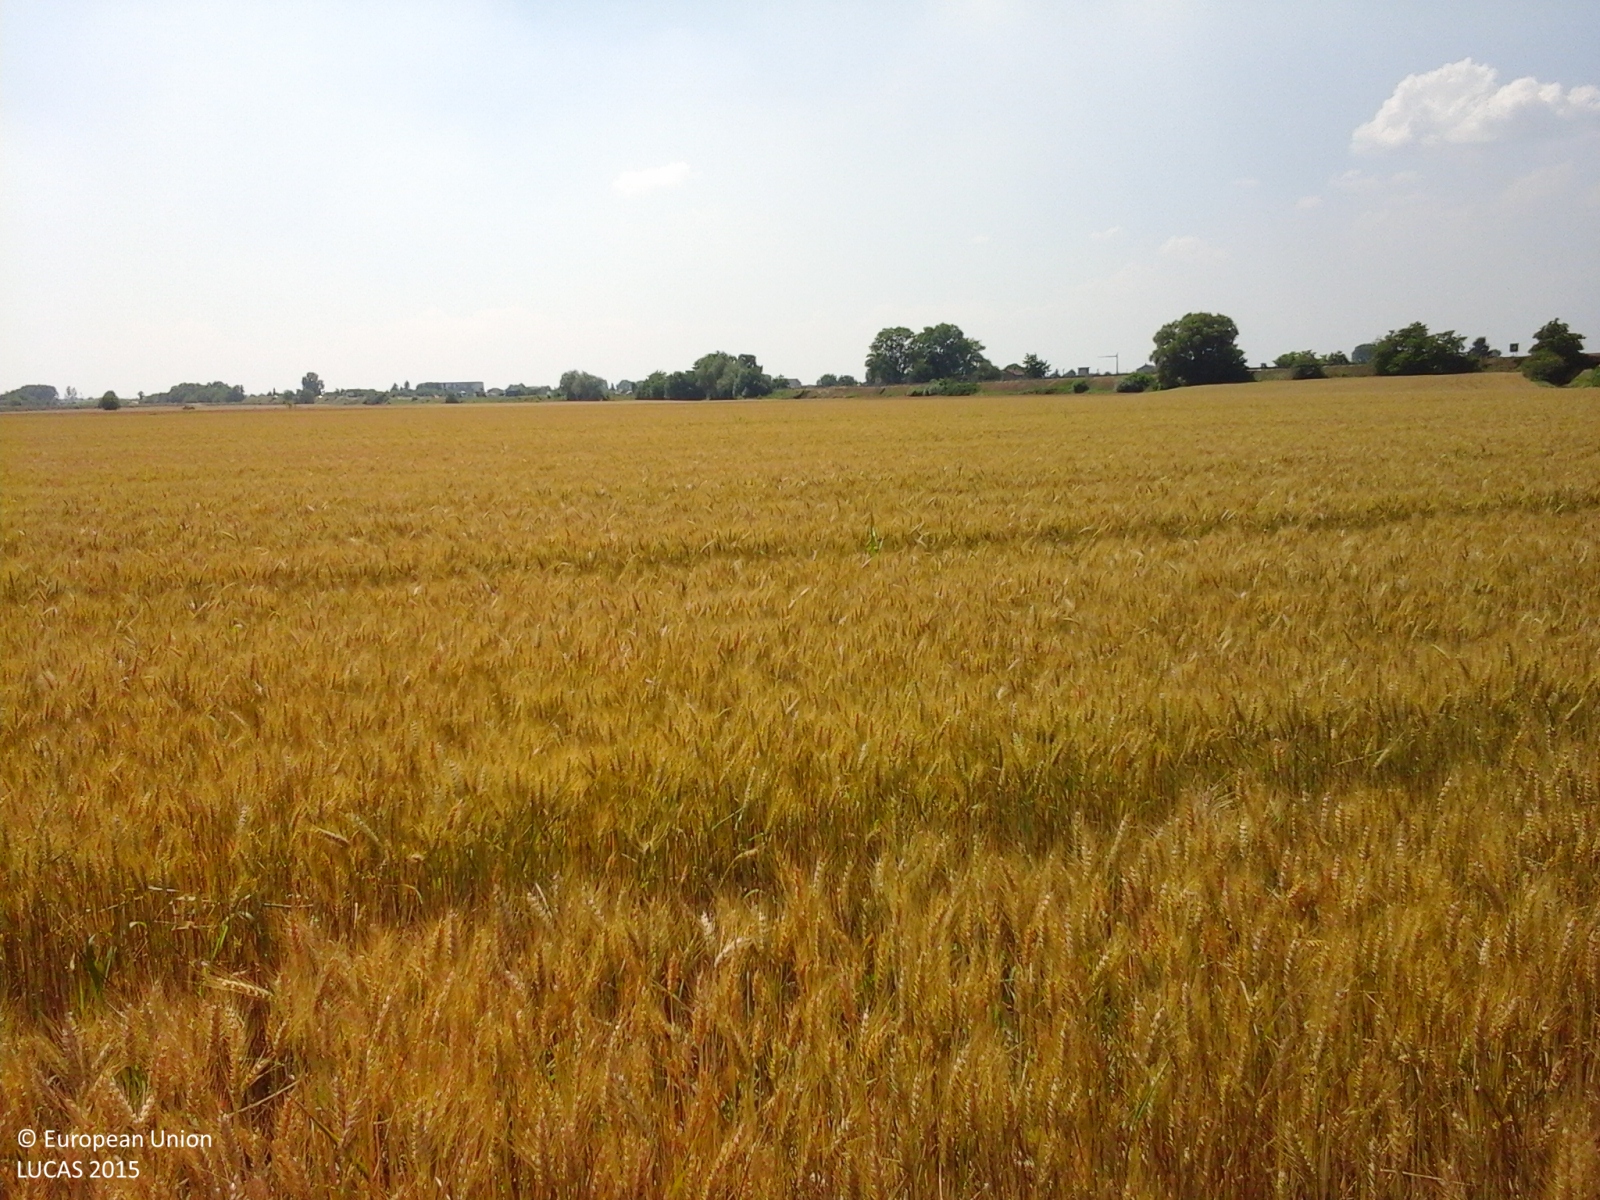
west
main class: Cropland
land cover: Common wheat
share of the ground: > 75 %
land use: Agriculture (excluding fallow land and kitchen gardens)
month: June
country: IT
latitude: 44.8638
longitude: 8.5727
